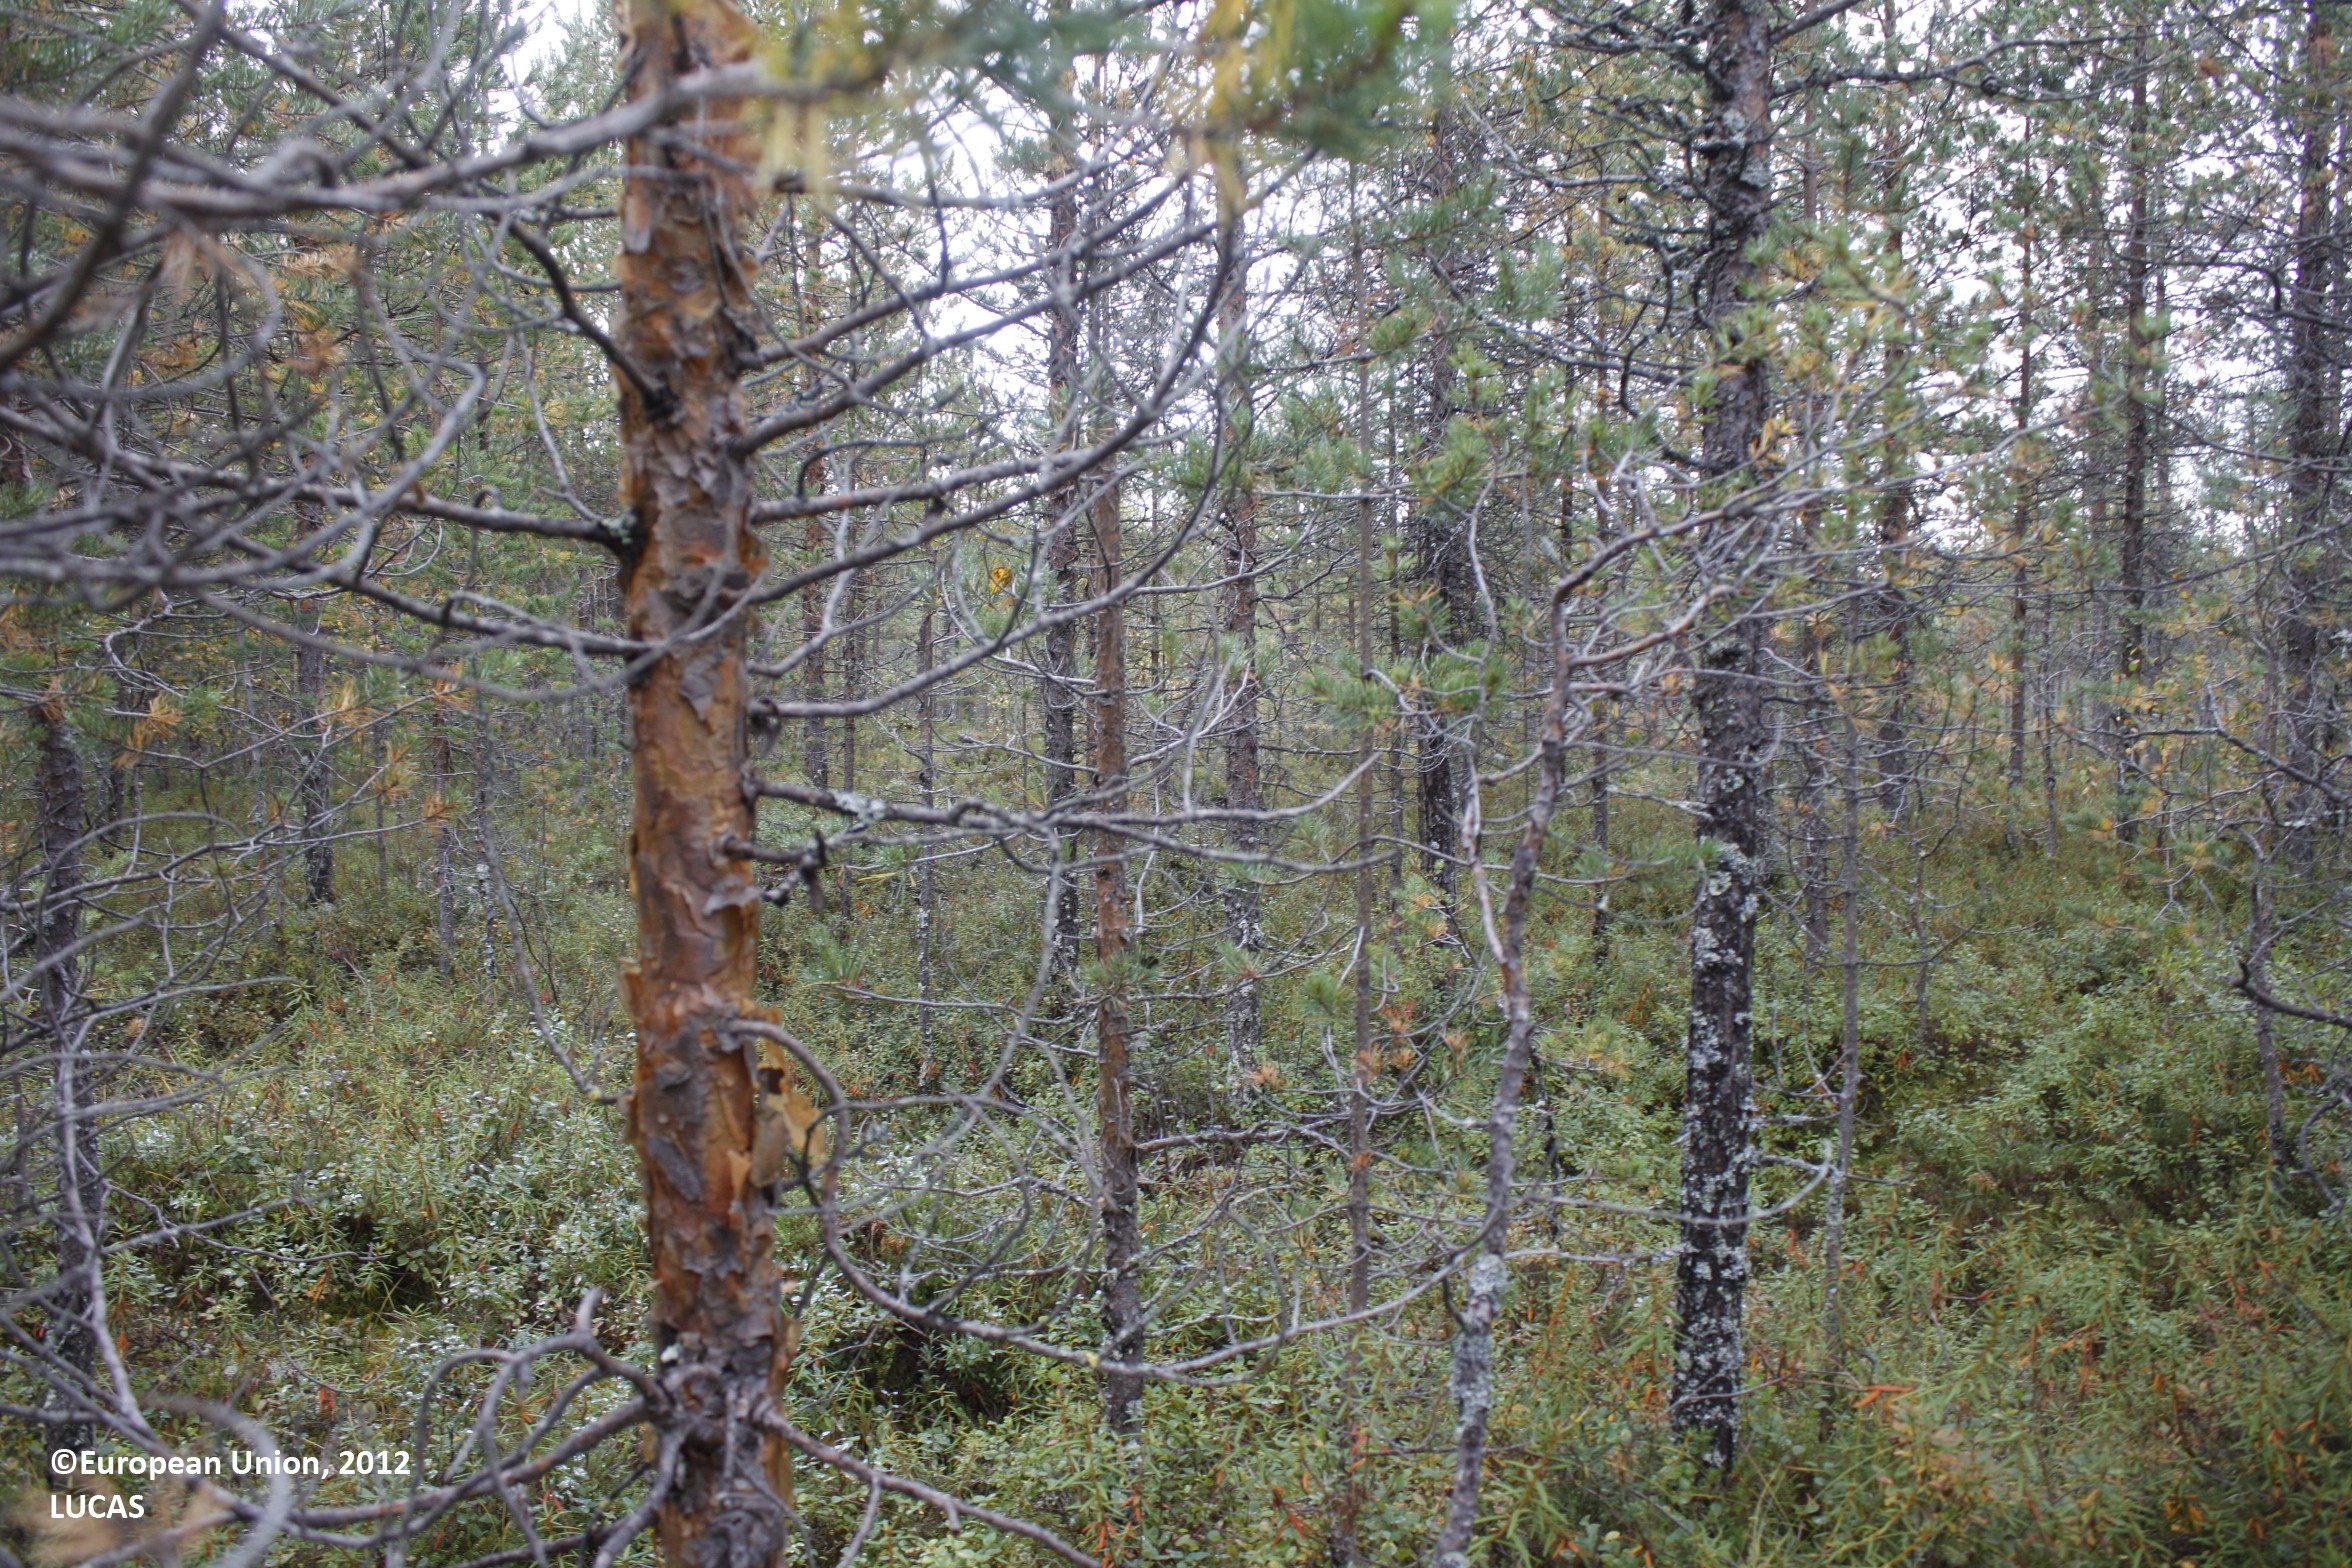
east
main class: Woodland
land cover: Pine dominated coniferous woodland
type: boreal forest
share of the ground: 50 - 75 %
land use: Forestry
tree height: > 5 m
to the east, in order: Pine dominated coniferous woodland; Ditches and canals; Pine dominated coniferous woodland; Inland running water; Pine dominated coniferous woodland; Peatbogs
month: September
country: FI
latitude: 65.1487
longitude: 26.7682
